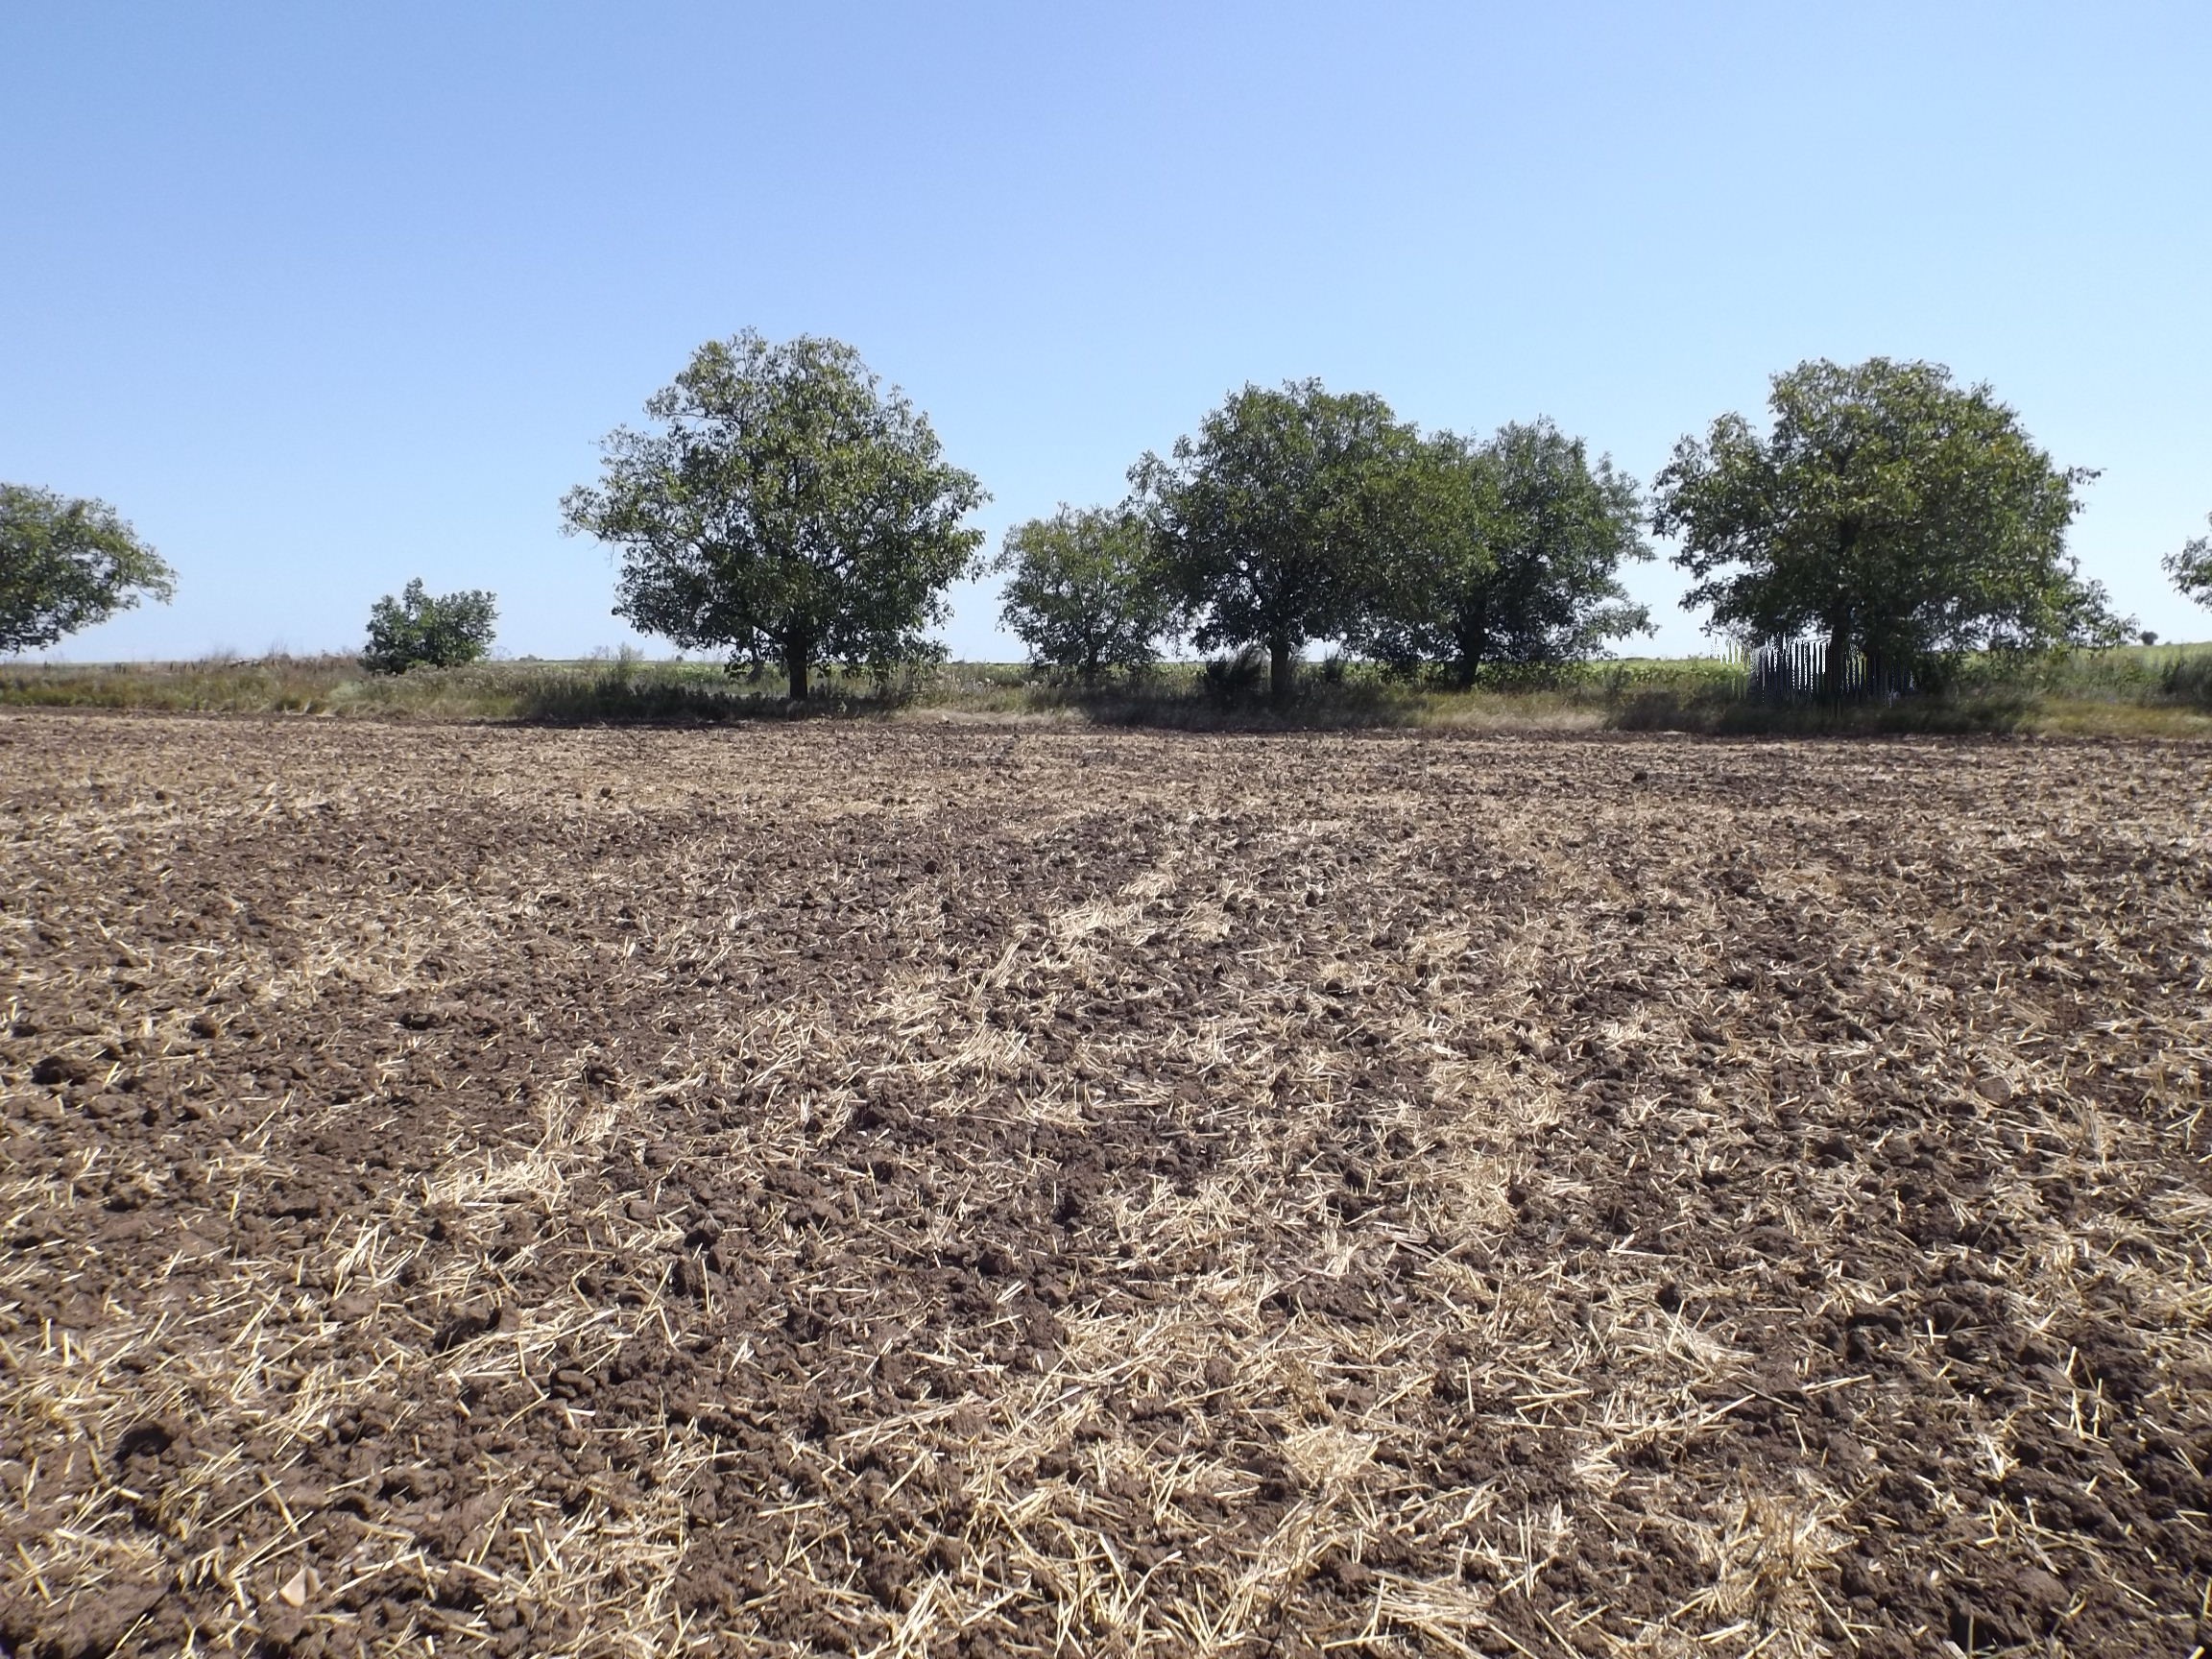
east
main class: Cropland
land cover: Common wheat
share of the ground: < 10 %
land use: Agriculture (excluding fallow land and kitchen gardens)
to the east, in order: Common wheat; Lines of trees; Ditches and canals; Paved roads, cycling and walking lanes; Lines of trees; Sunflower; Grassland with sparse tree/shrub cover; Tracks; Common wheat
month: August
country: BG
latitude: 43.2596
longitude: 27.8904
